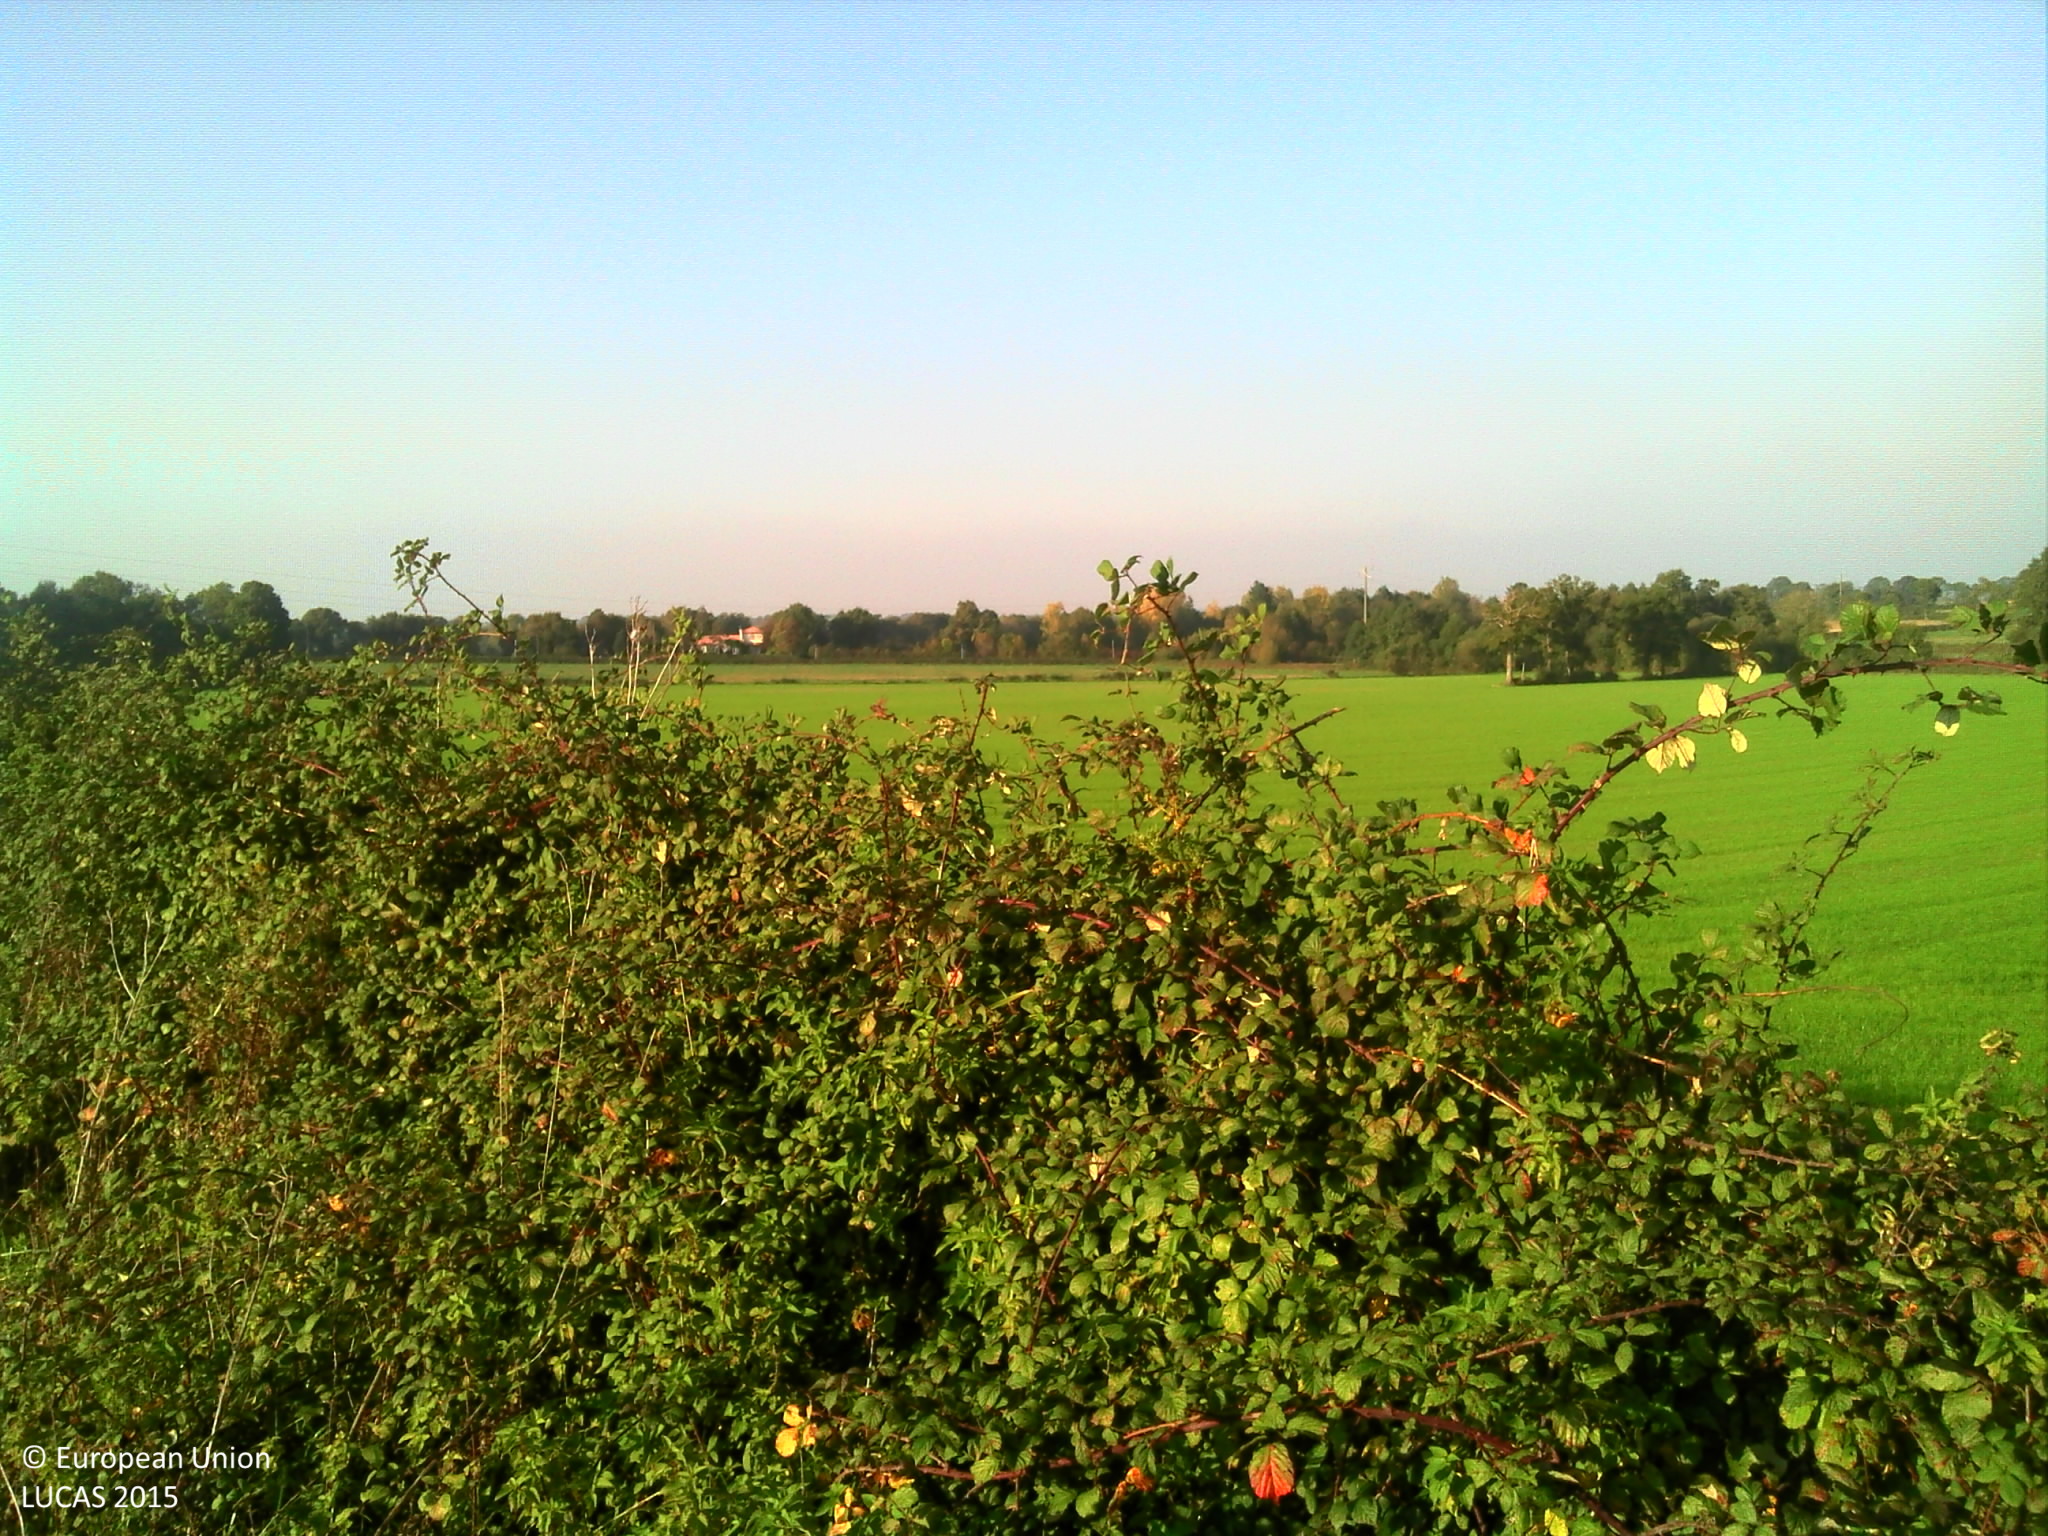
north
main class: Cropland
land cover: Temporary grasslands
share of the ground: 50 - 75 %
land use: Agriculture (excluding fallow land and kitchen gardens)
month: October
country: FR
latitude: 47.0209
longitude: -0.9669
